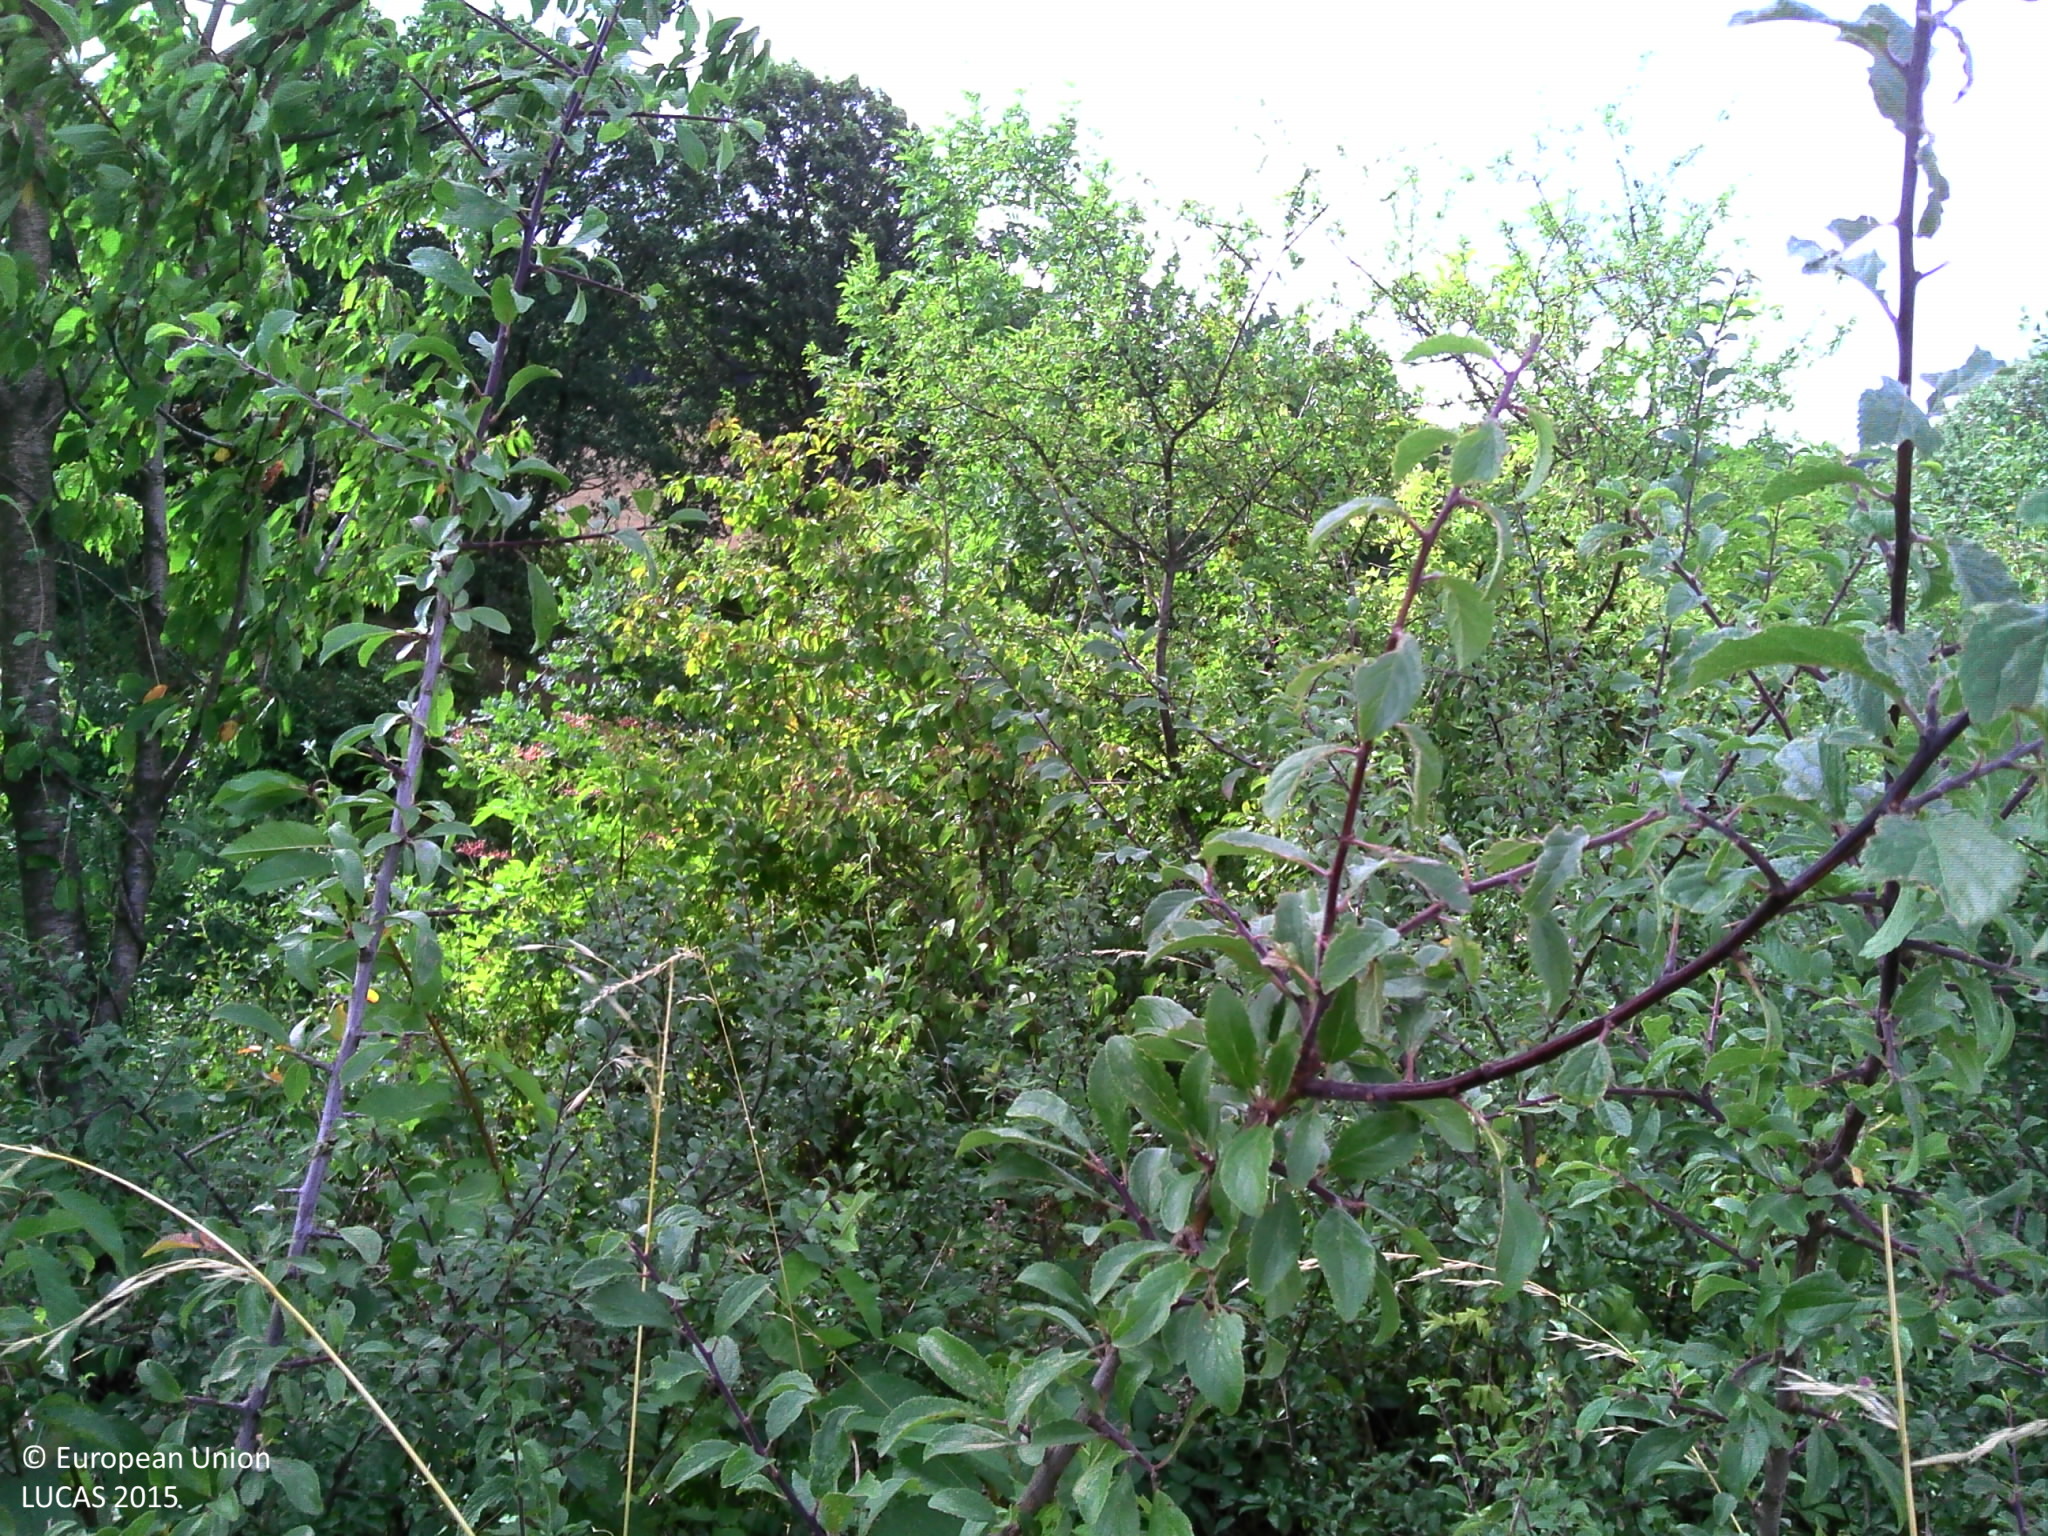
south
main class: Woodland
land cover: Broadleaved woodland
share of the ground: 50 - 75 %
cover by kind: broadleaved forest trees 50 %, shrubs 40 %, herbaceous plants 10 %
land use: Railway transport
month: July
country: BE
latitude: 49.6219
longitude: 5.8324
